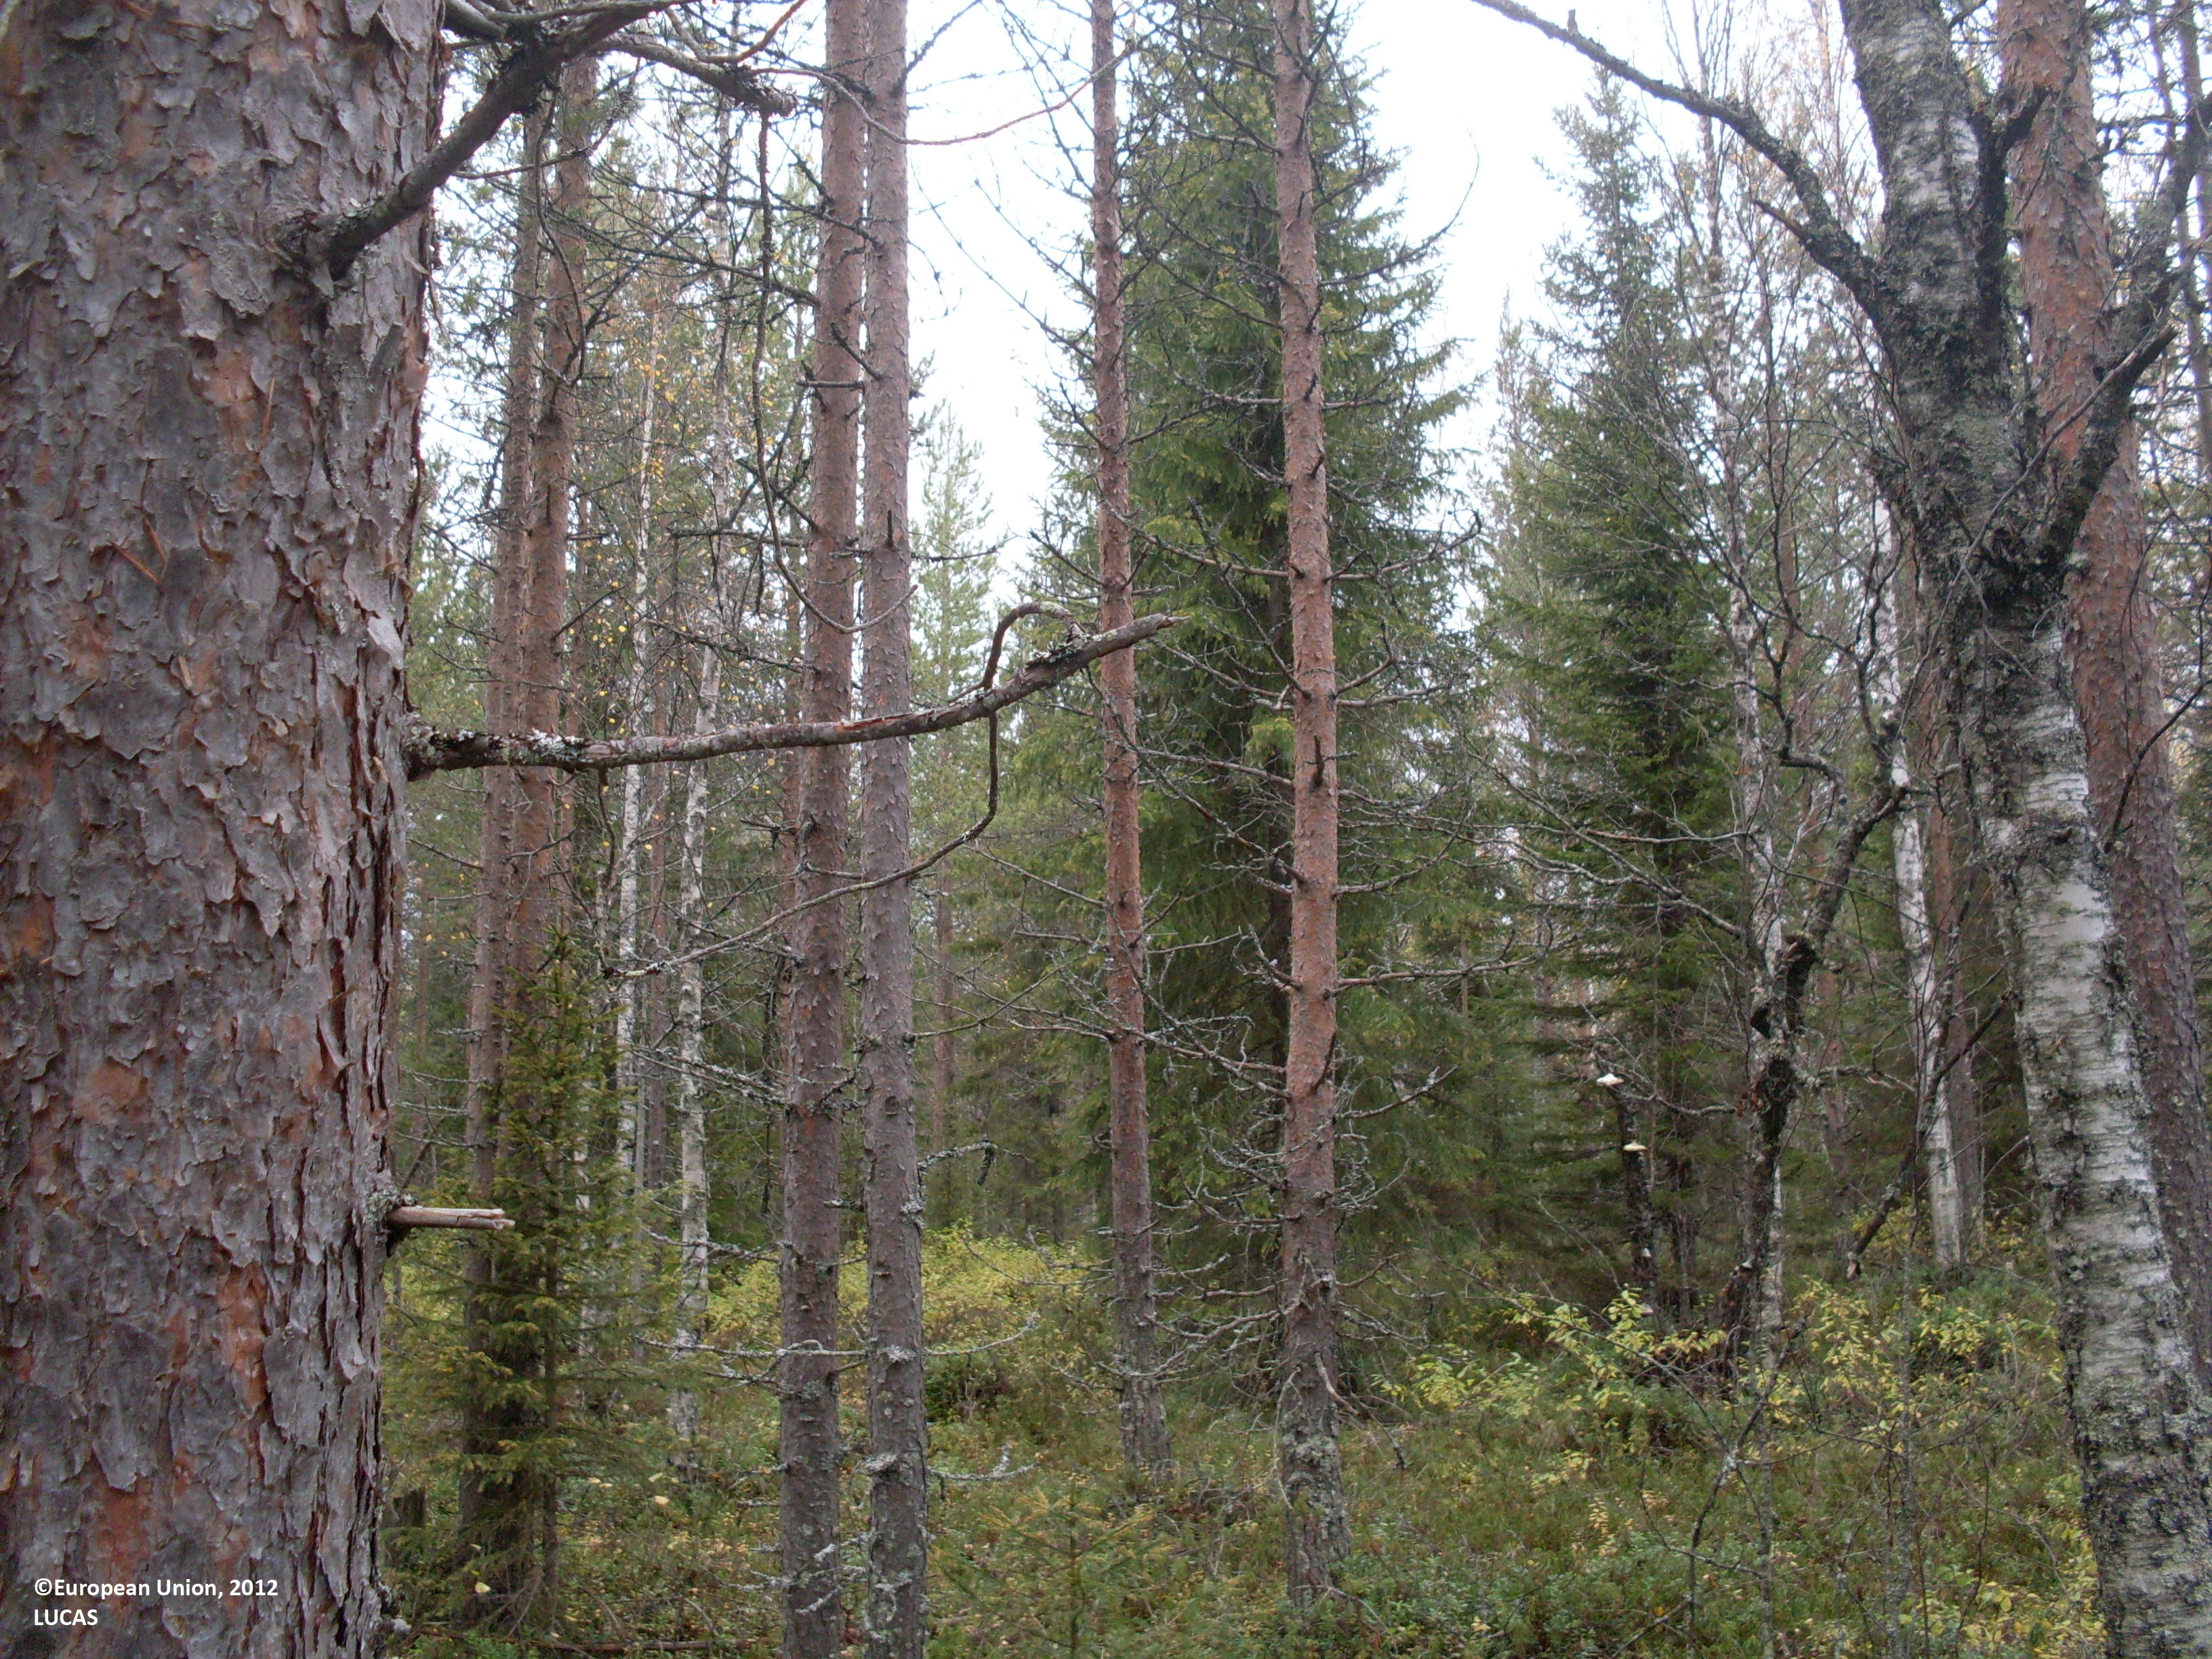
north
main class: Woodland
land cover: Pine dominated mixed woodland
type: boreal forest
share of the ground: 50 - 75 %
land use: Forestry
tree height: > 5 m
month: September
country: FI
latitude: 64.8784
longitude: 28.6916
